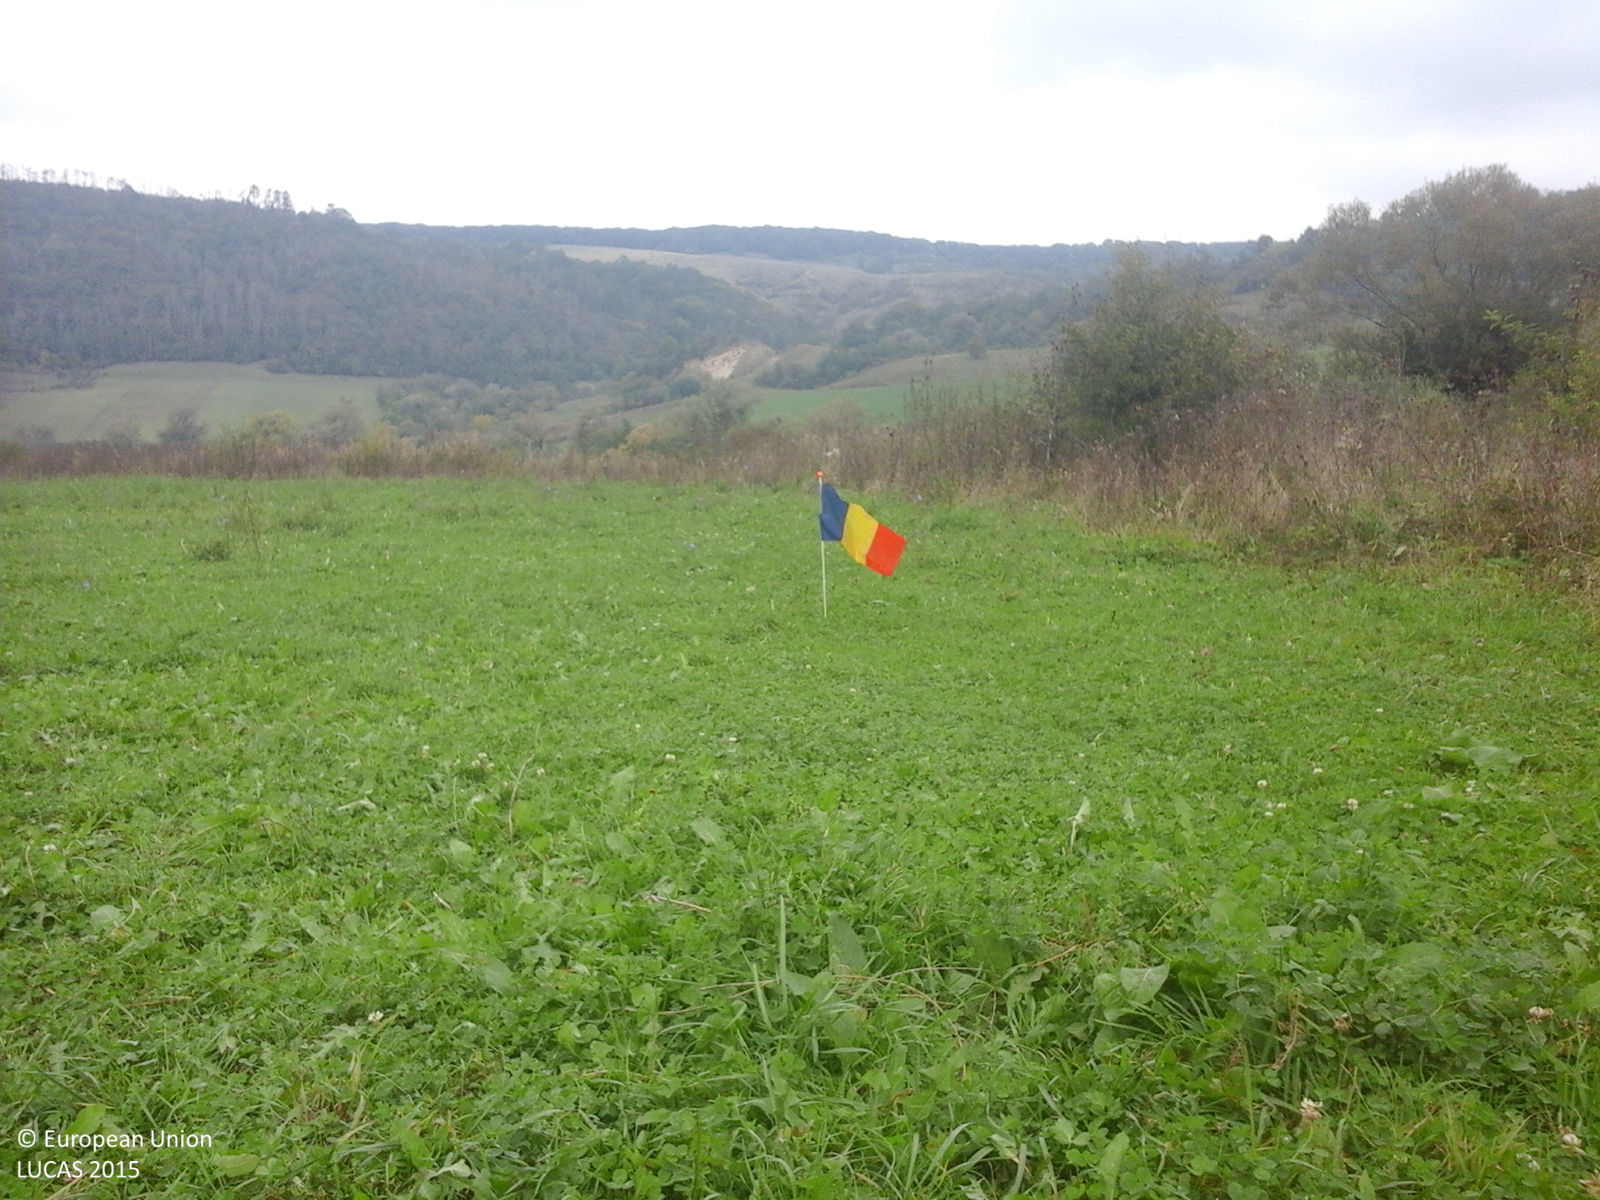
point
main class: Cropland
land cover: Other leguminous and mixtures for fodder
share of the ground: > 75 %
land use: Agriculture (excluding fallow land and kitchen gardens)
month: October
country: RO
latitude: 46.1401
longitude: 24.9151
